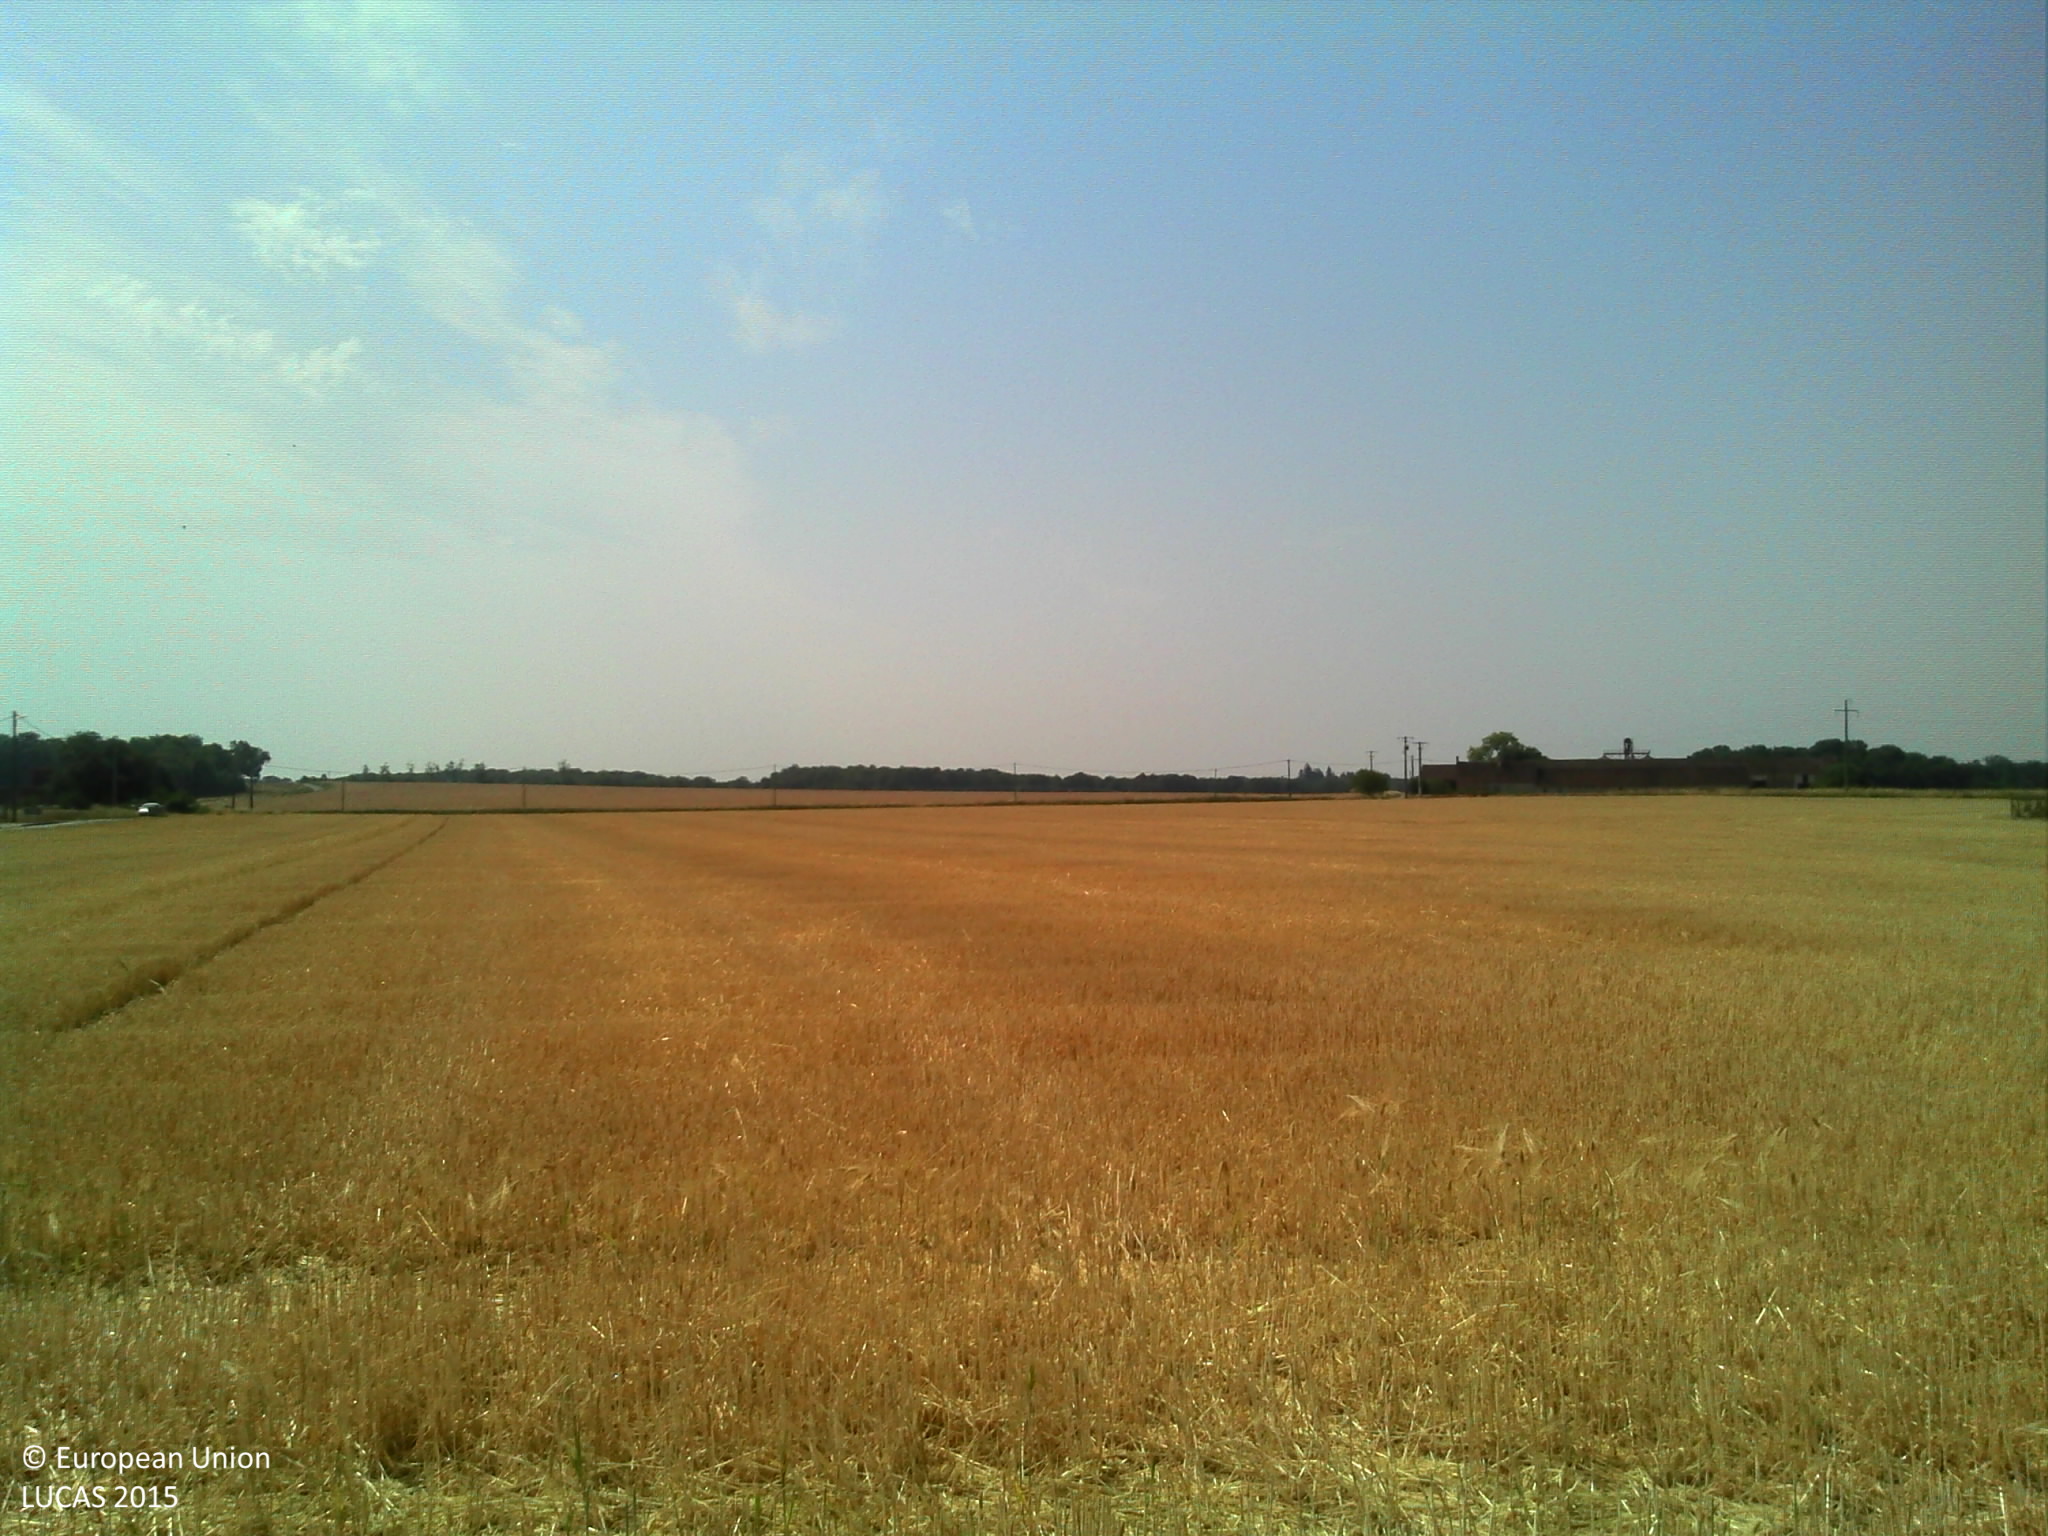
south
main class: Cropland
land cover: Barley
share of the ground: > 75 %
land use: Agriculture (excluding fallow land and kitchen gardens)
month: July
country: FR
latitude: 47.8105
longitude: 2.8484
